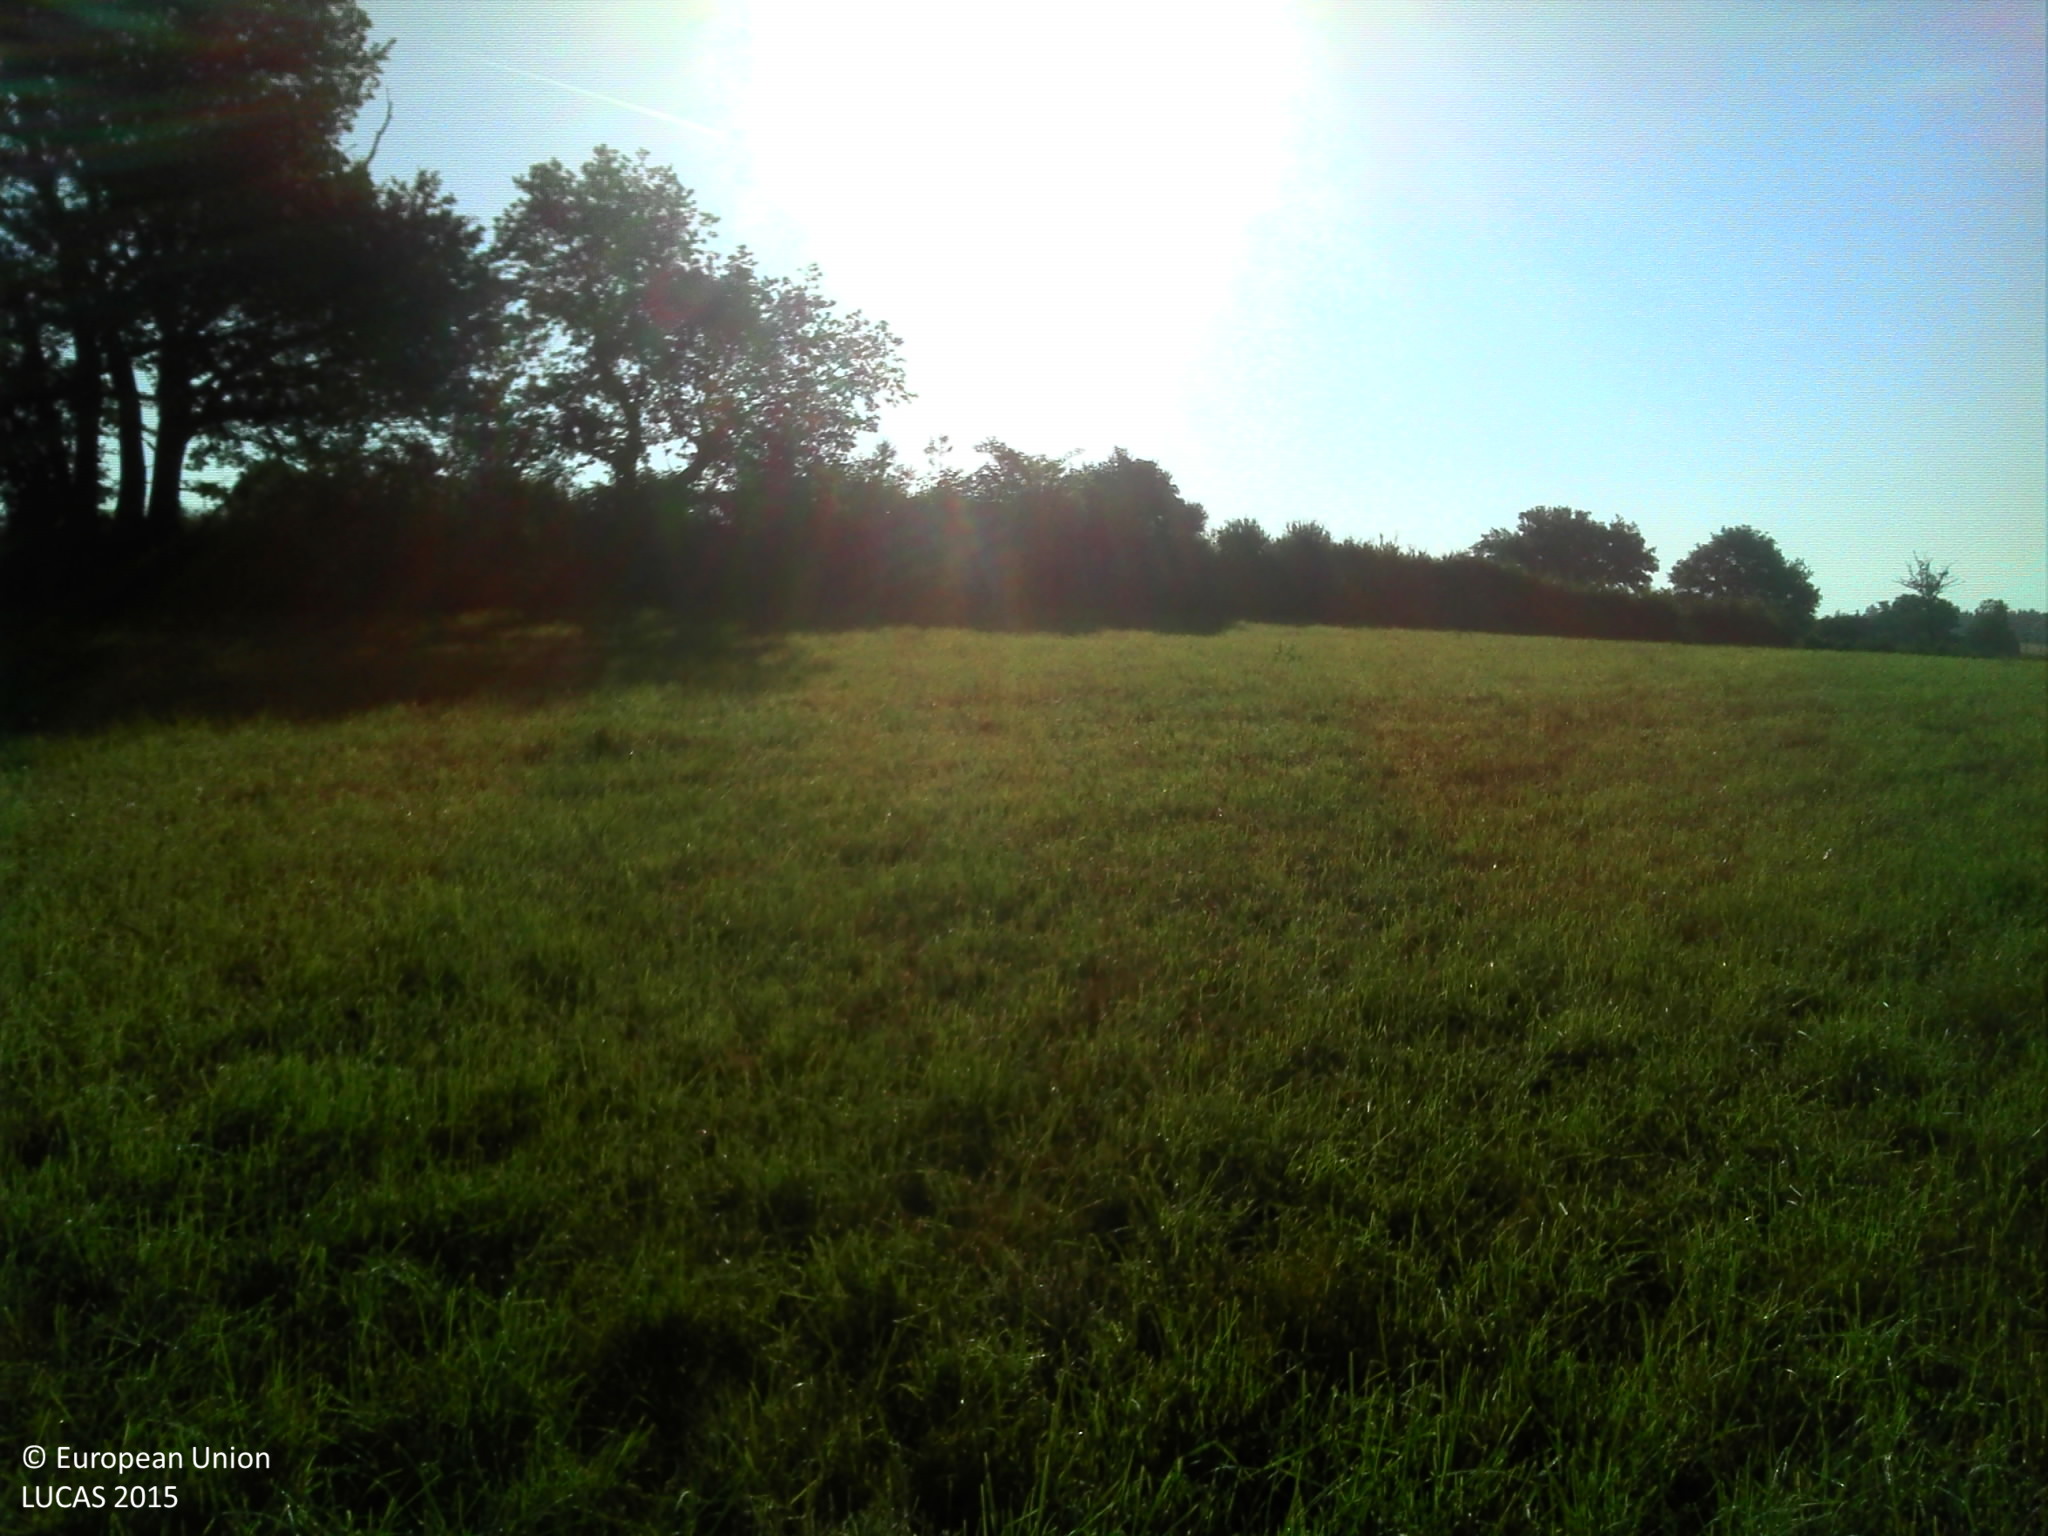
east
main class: Grassland
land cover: Grassland without tree/shrub cover
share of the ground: > 75 %
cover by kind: herbaceous plants 100 %
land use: Agriculture (excluding fallow land and kitchen gardens)
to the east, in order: Grassland without tree/shrub cover; Managed hedges; Fences; Grassland without tree/shrub cover; Single bushes/trees; Managed hedges; Fences; Grassland without tree/shrub cover; Abandoned hedges; Fences; Grassland without tree/shrub cover
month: June
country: FR
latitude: 46.4222
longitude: 4.4193
